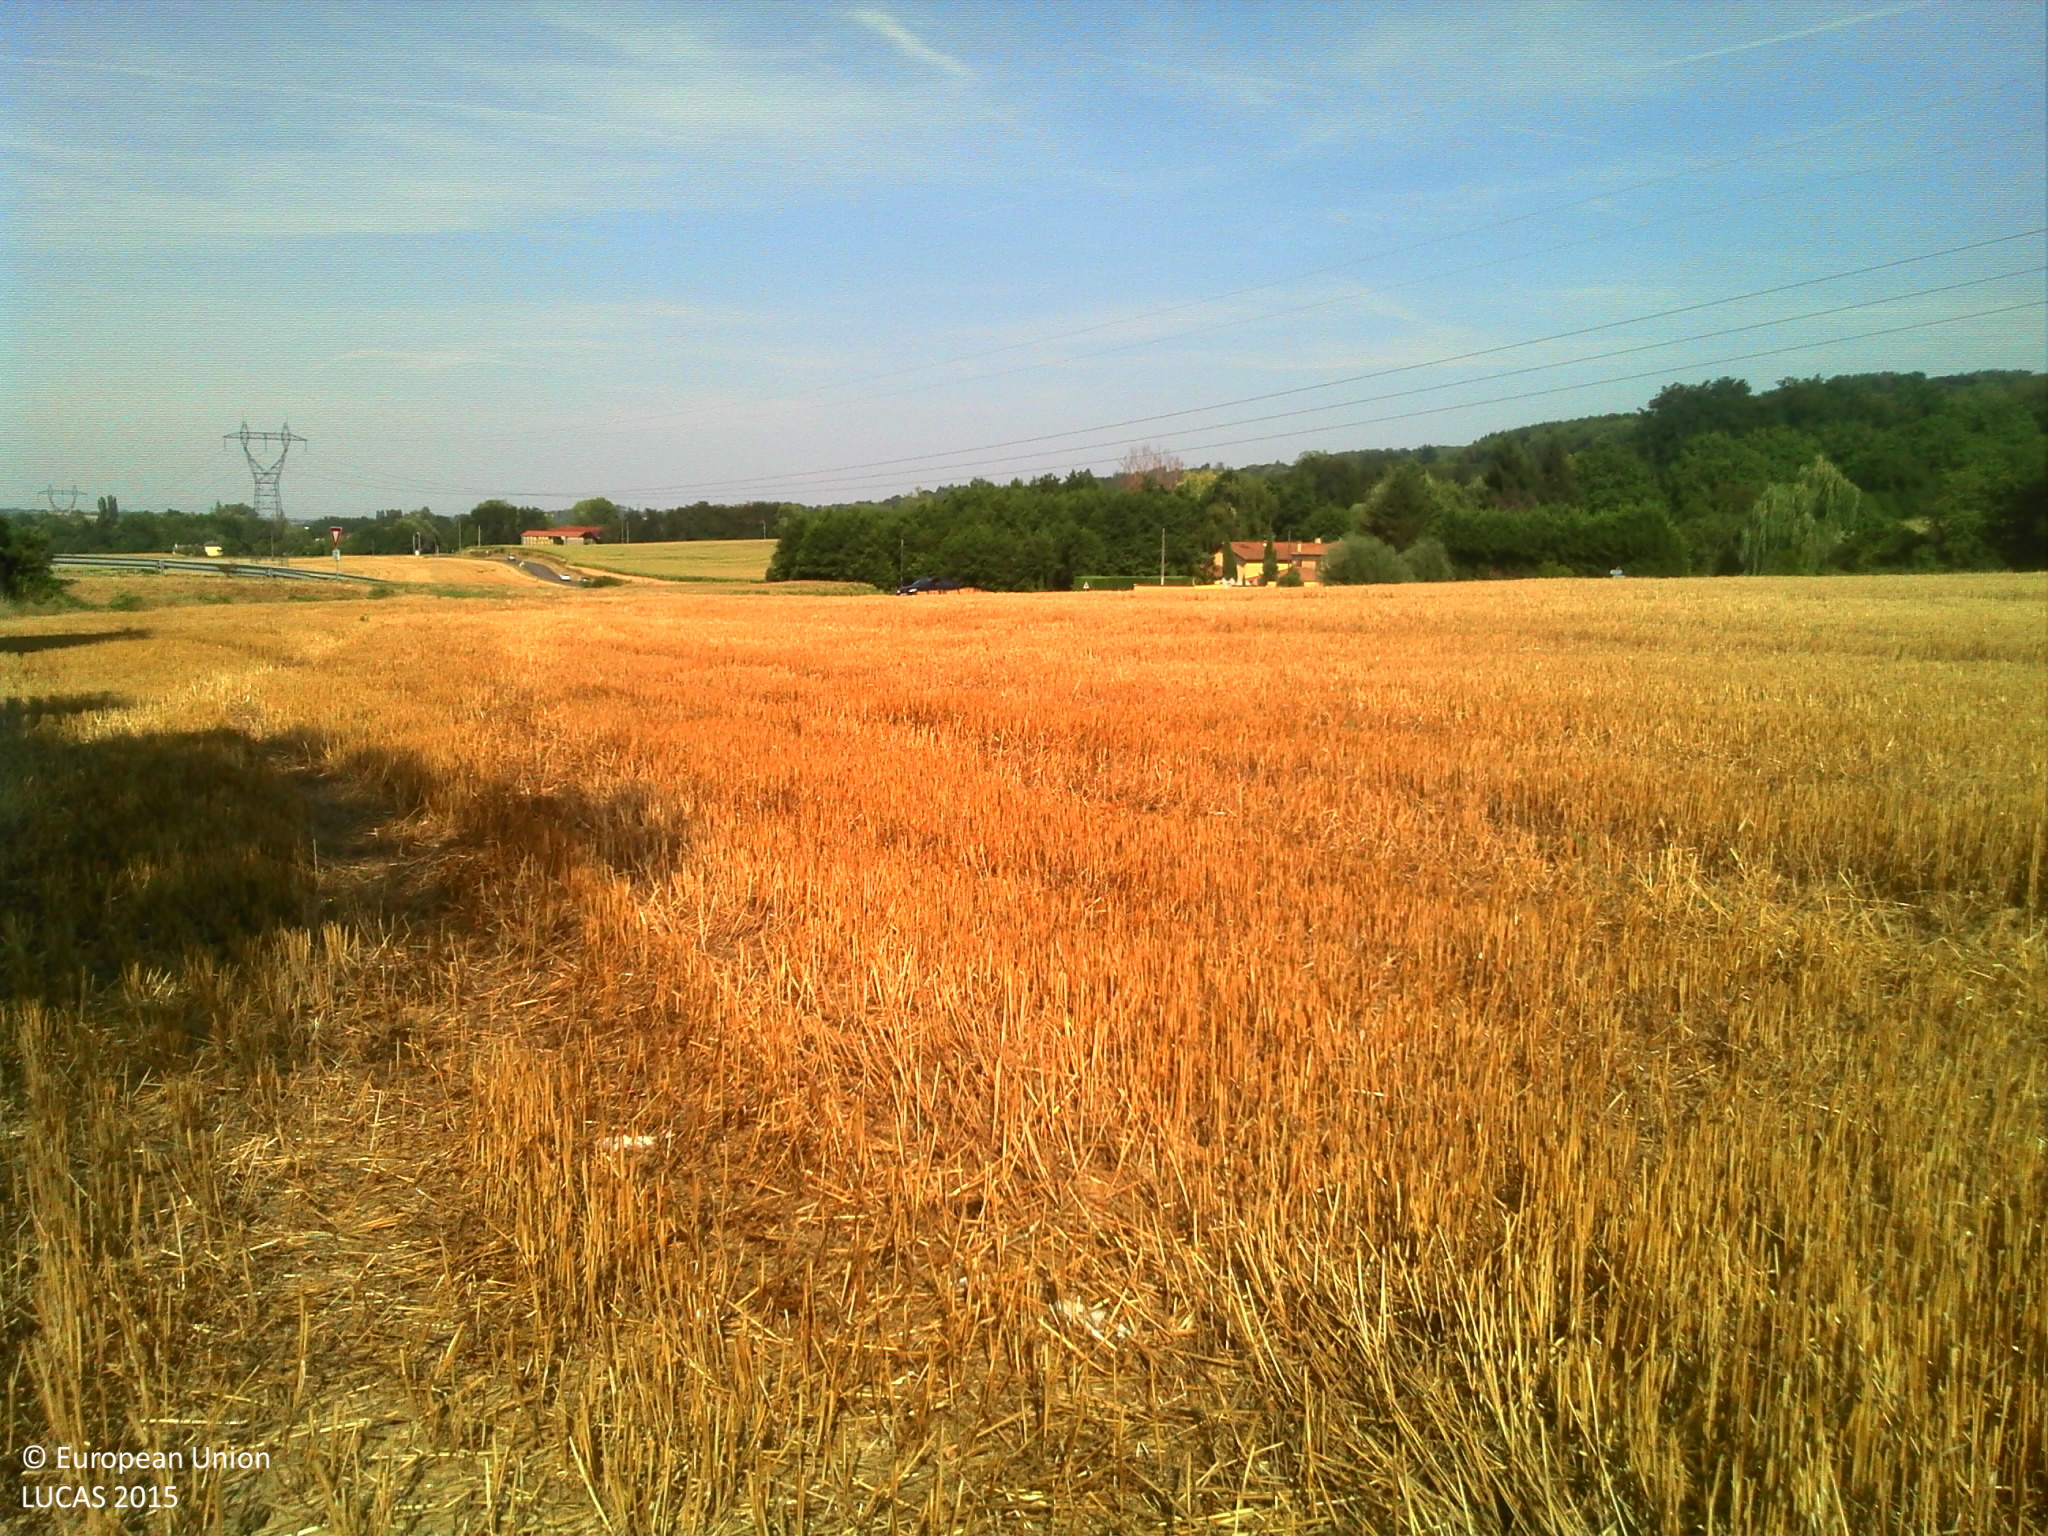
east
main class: Cropland
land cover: Durum wheat
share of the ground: 10 - 25 %
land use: Agriculture (excluding fallow land and kitchen gardens)
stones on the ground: 25 - 50 %
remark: Harvested field
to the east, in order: Durum wheat; Grass margins; Paved roads, cycling and walking lanes; Grass margins; Common wheat; Electric lines; Common wheat; Artificial constructions in urban areas; Broadleaved woodland
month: August
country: FR
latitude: 45.6153
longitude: 4.8873
